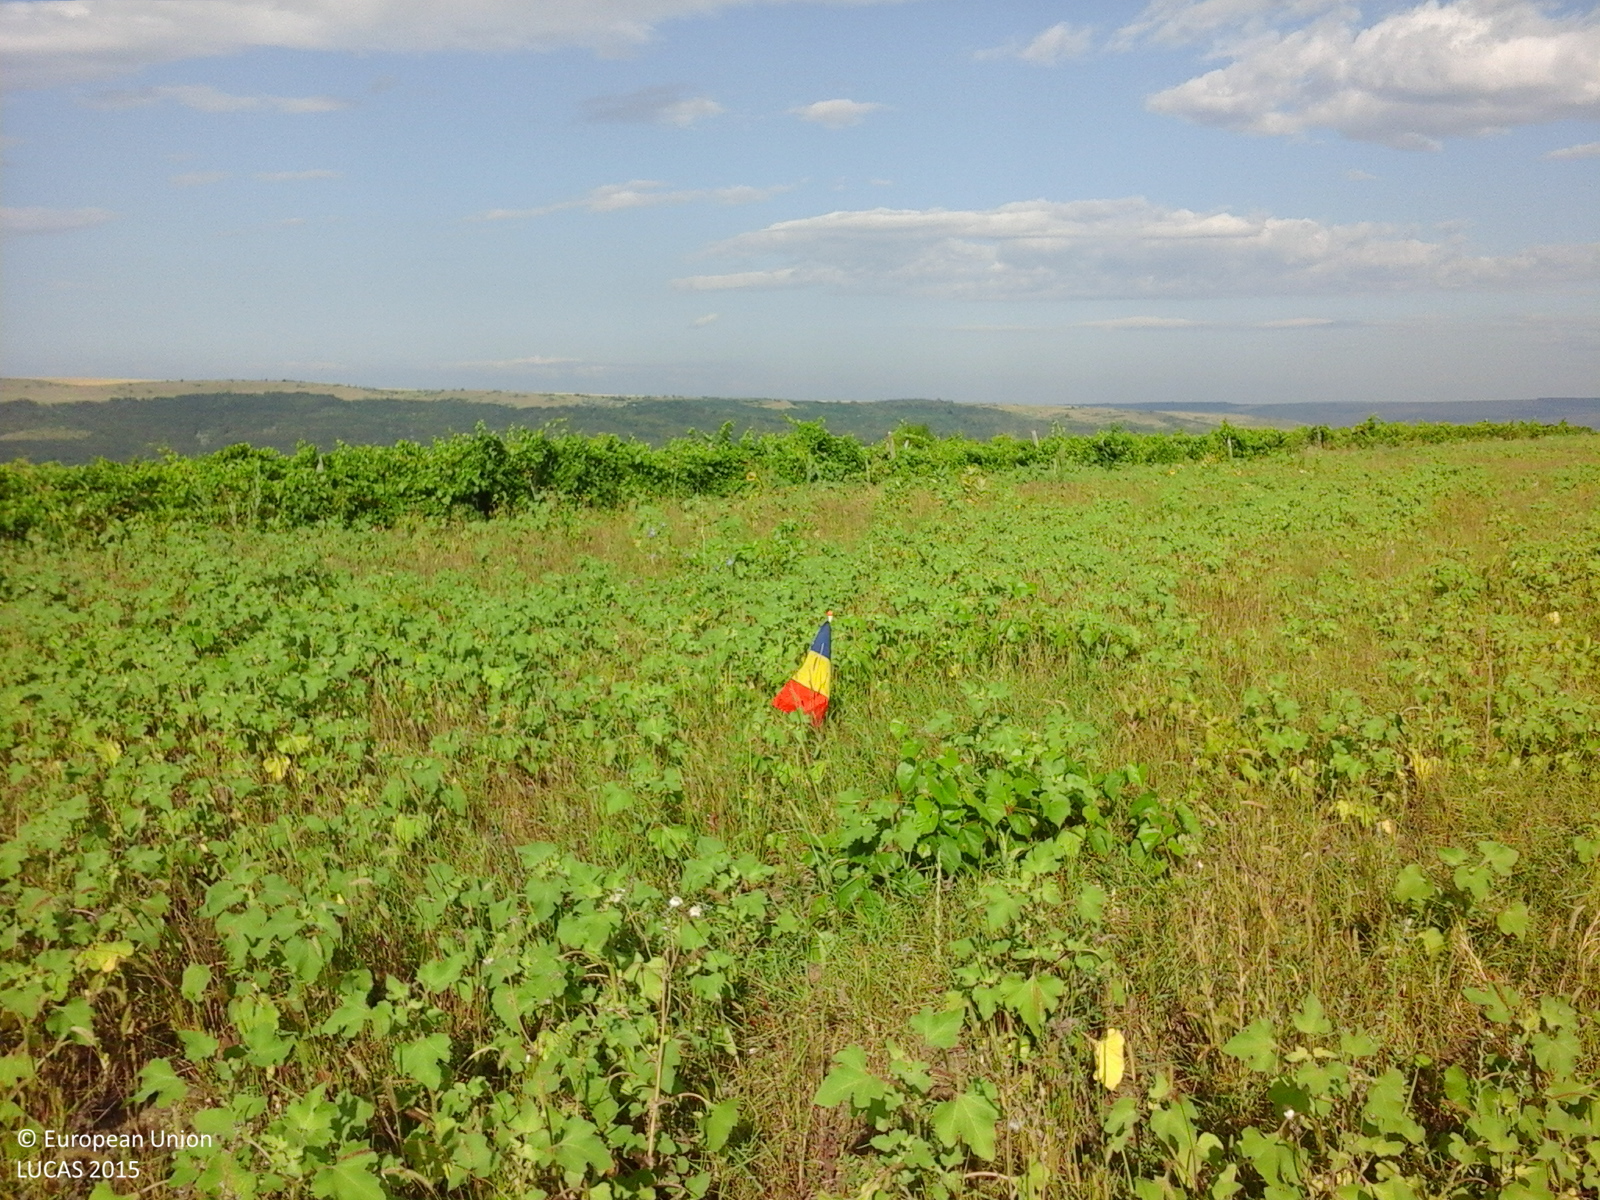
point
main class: Grassland
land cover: Spontaneously vegetated surfaces
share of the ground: > 75 %
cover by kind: herbaceous plants 100 %
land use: Abandoned areas
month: July
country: RO
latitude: 46.1521
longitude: 27.6839
